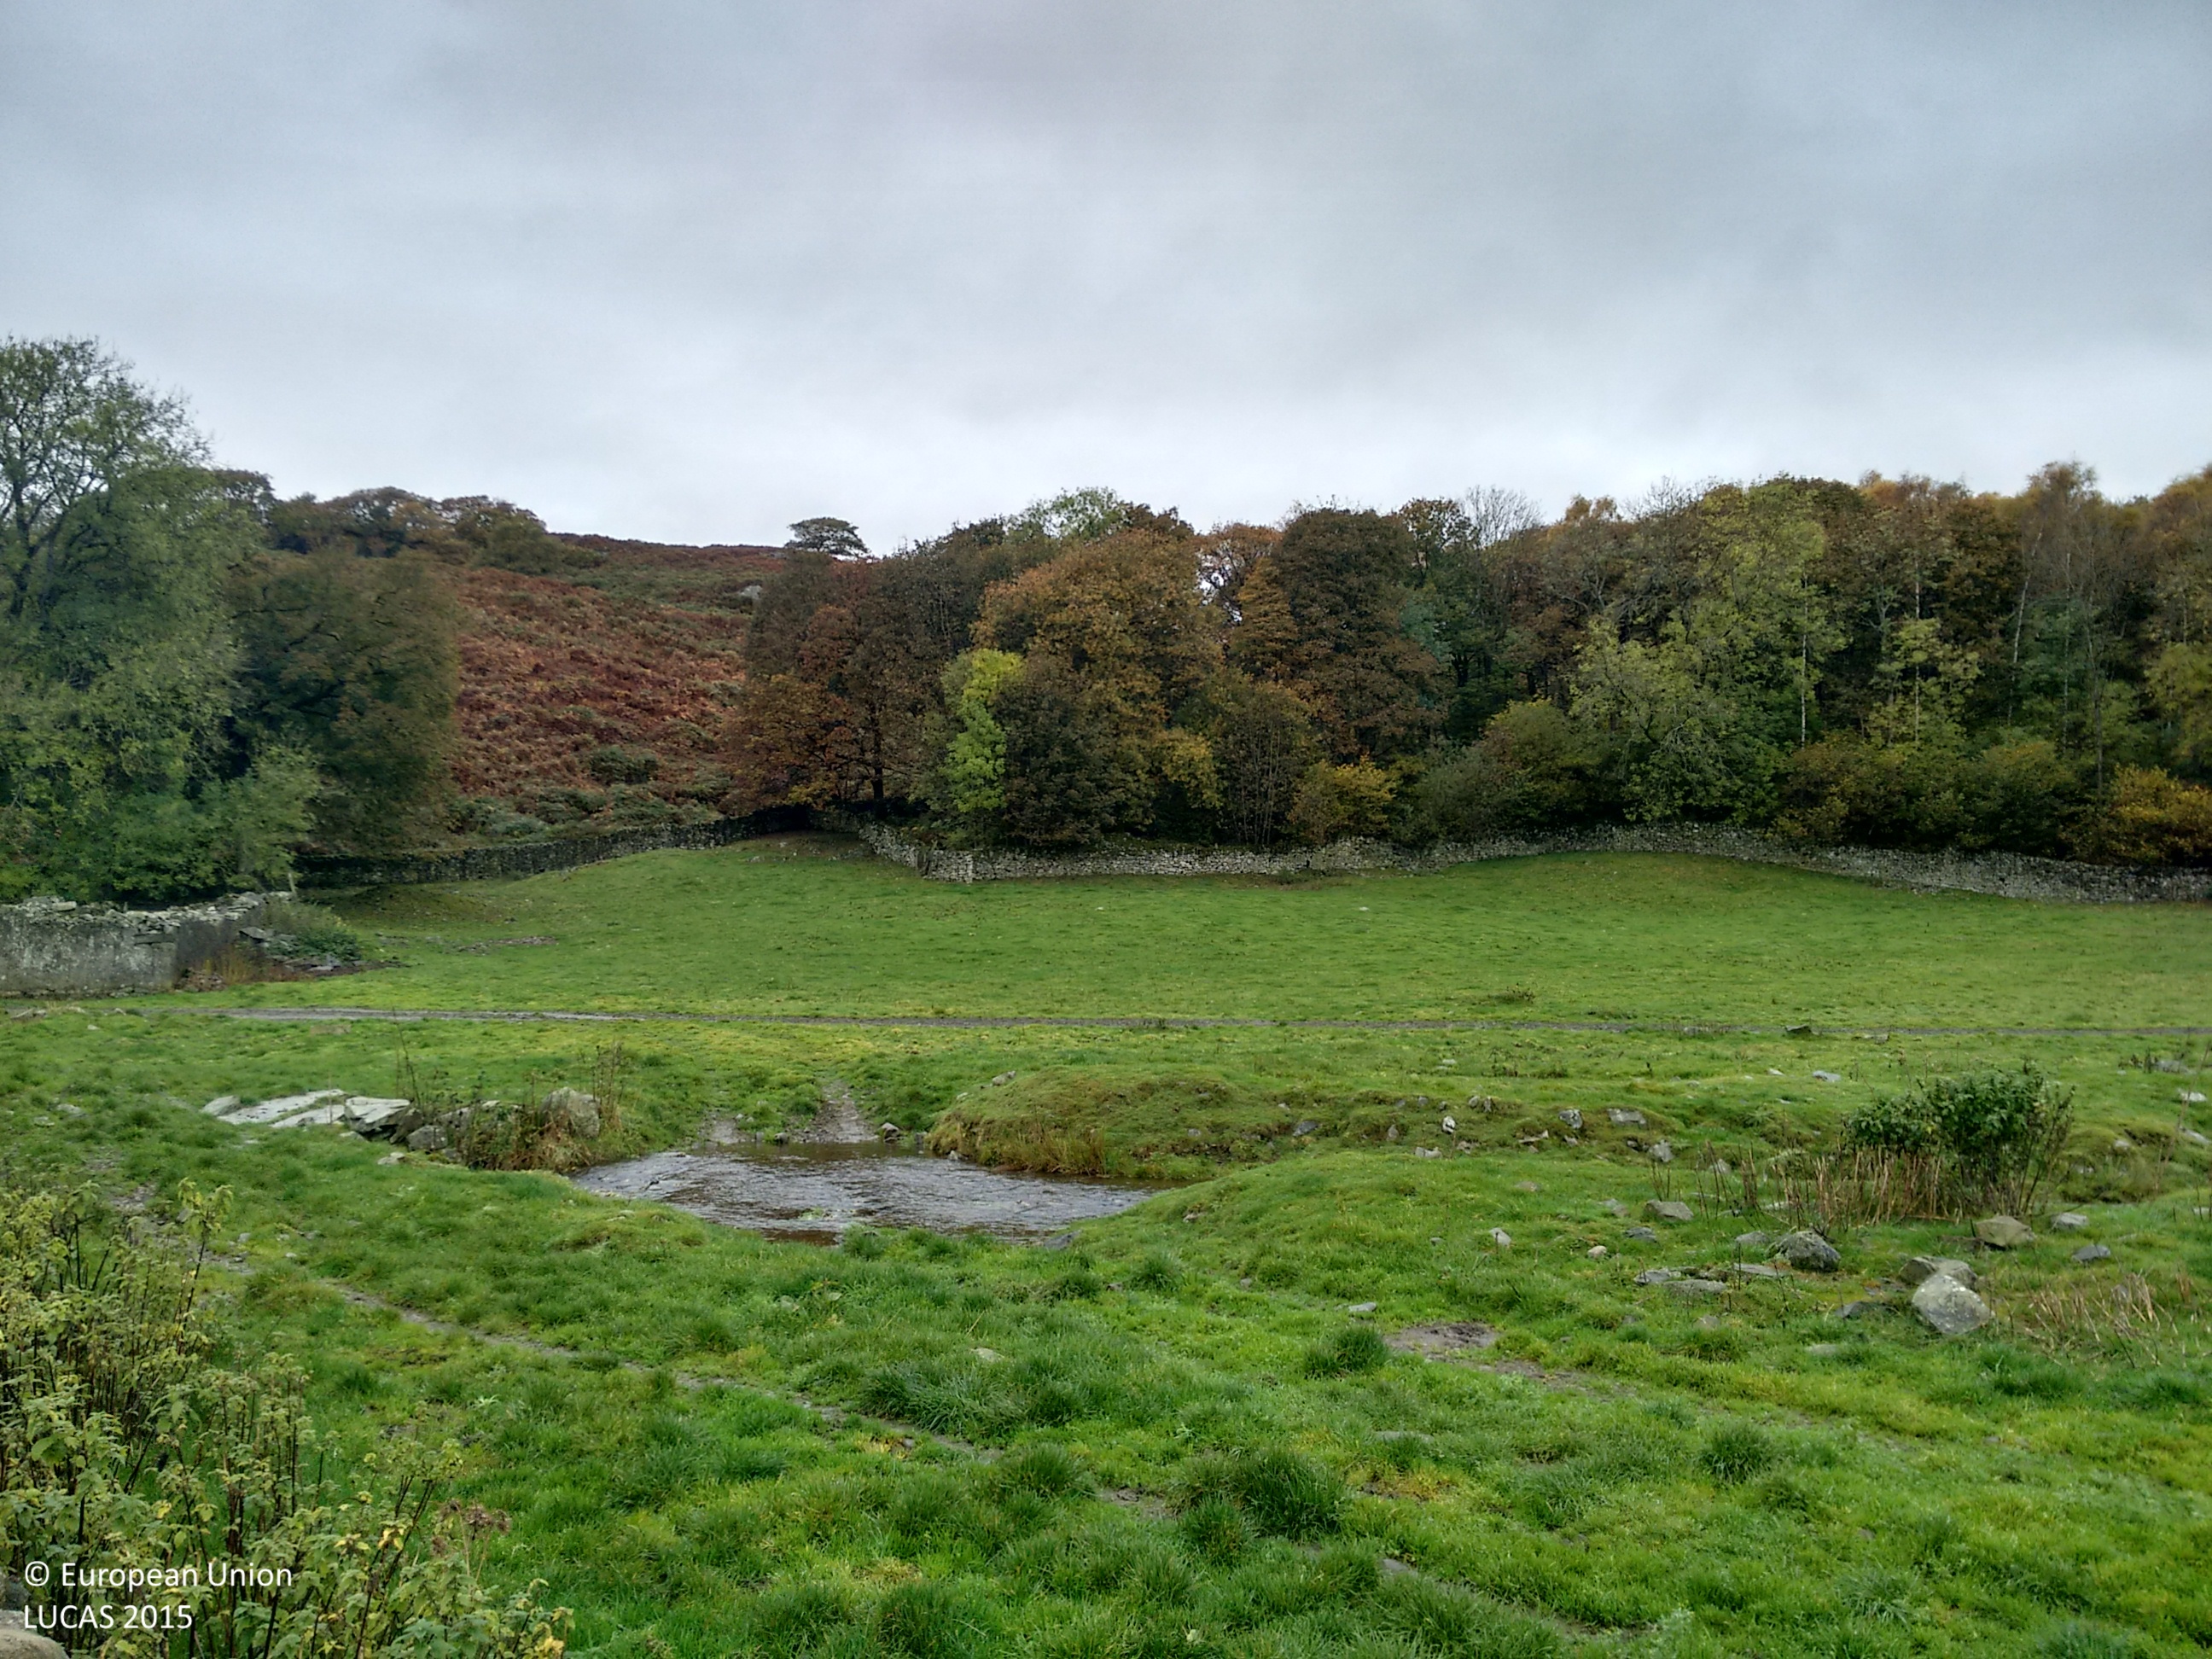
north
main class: Grassland
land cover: Grassland without tree/shrub cover
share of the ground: > 75 %
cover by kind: herbaceous plants 100 %
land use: Agriculture (excluding fallow land and kitchen gardens)
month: October
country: GB
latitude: 54.3030
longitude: -3.1535
